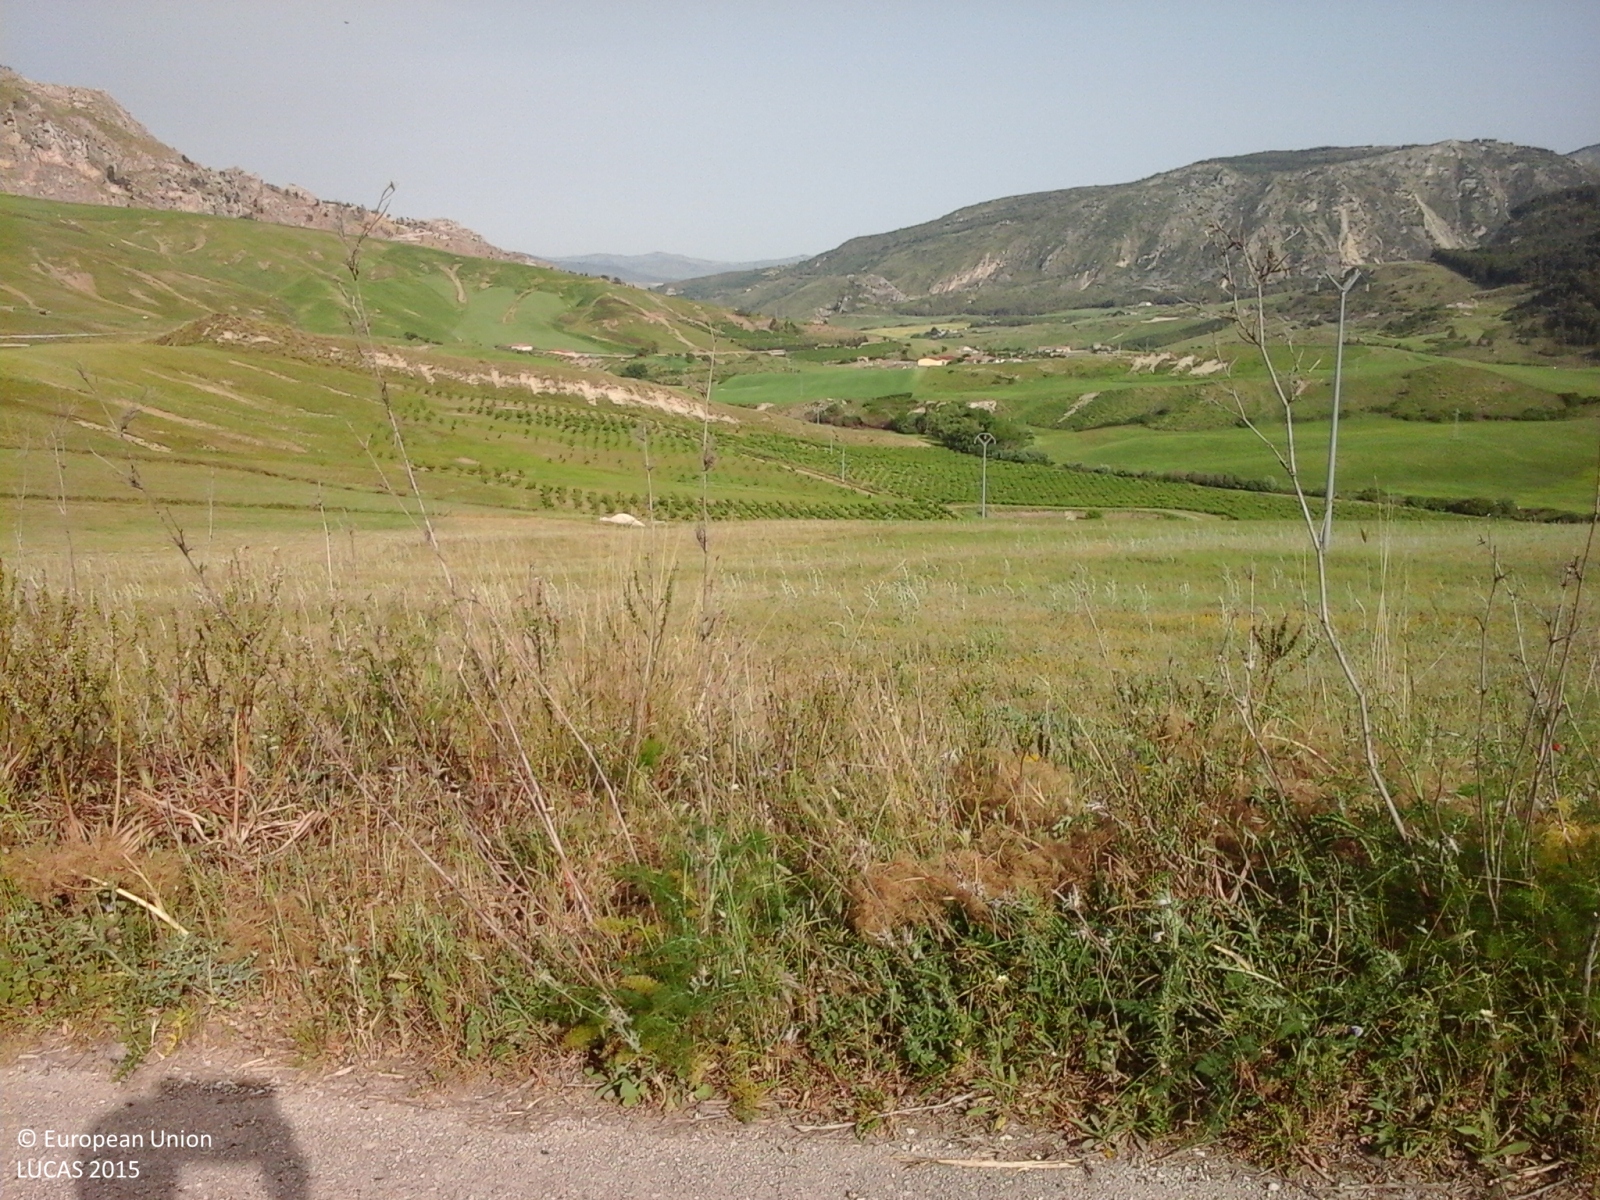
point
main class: Cropland
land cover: Other fruit trees and berries
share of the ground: > 75 %
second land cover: Other bare soil
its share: > 75 %
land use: Agriculture (excluding fallow land and kitchen gardens)
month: May
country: IT
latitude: 37.6806
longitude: 13.5680
